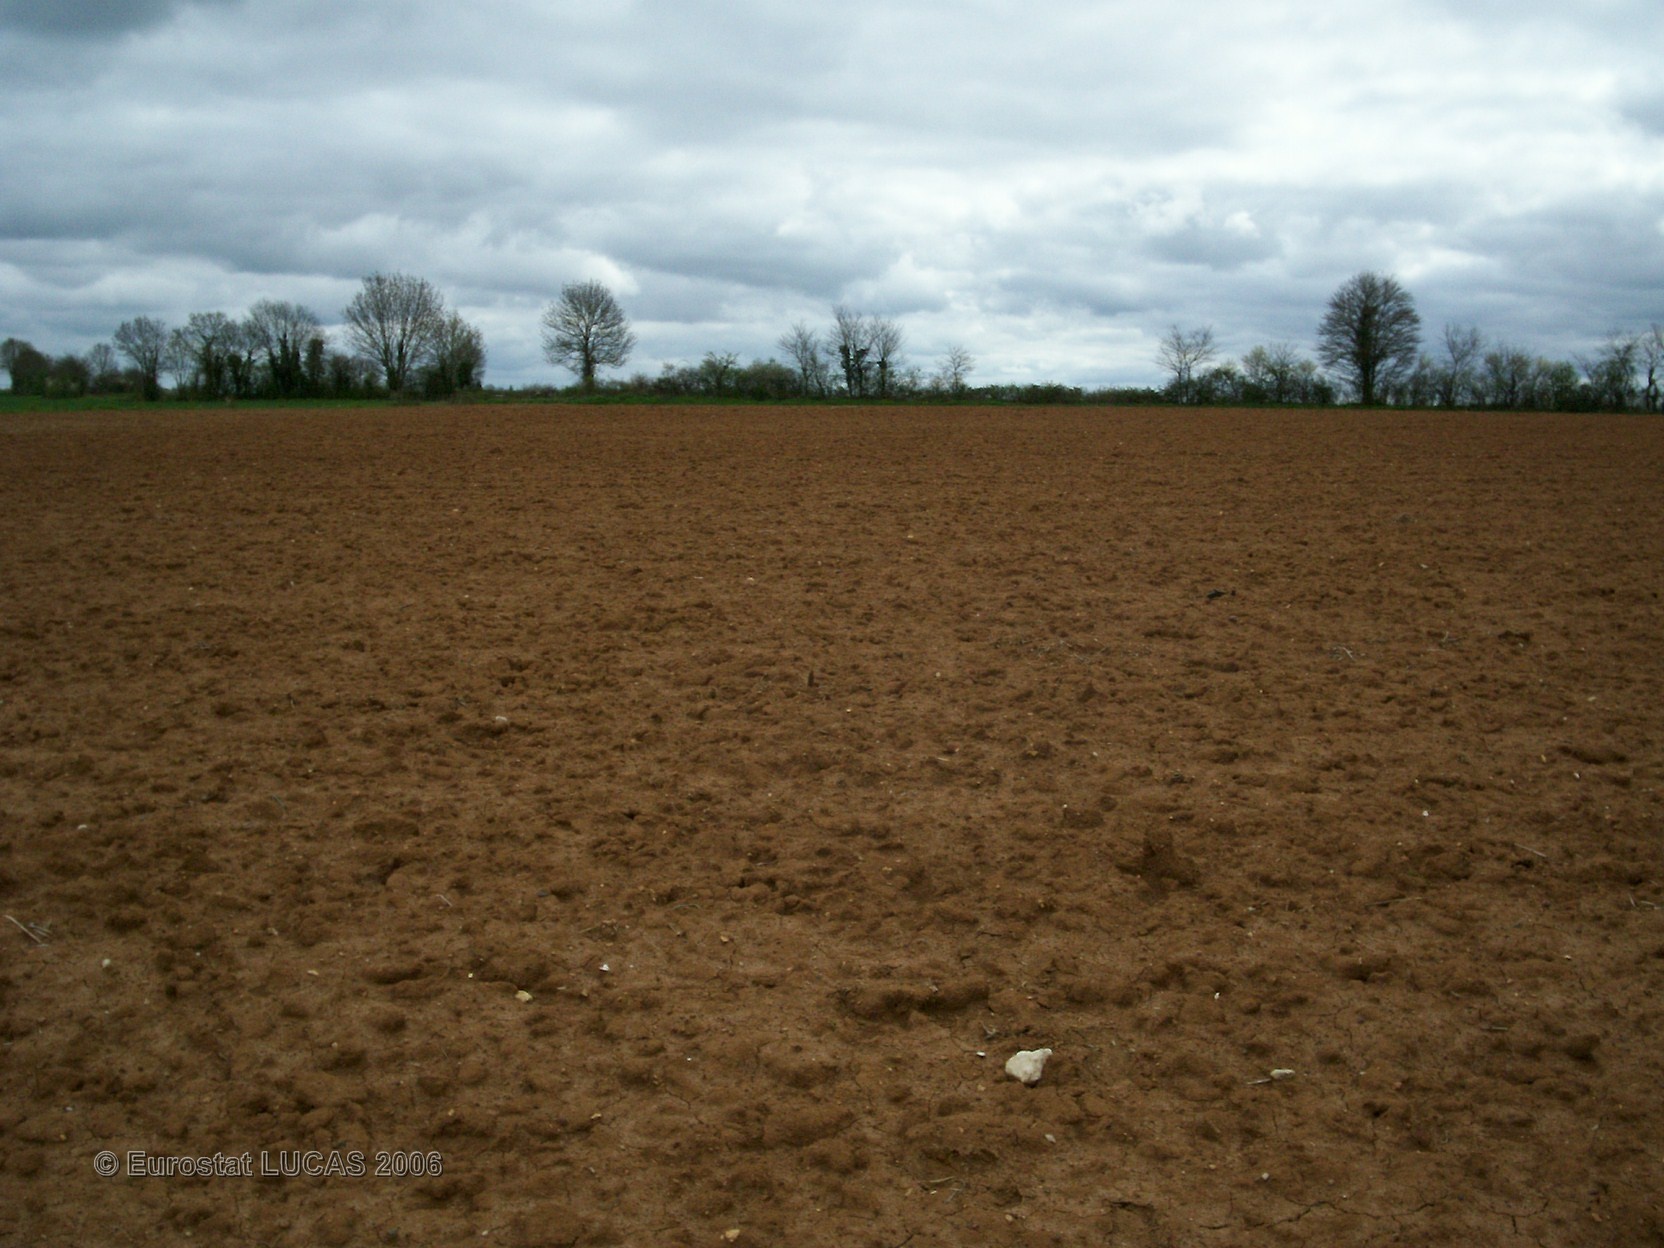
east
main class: Cropland
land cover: Maize
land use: Agriculture (excluding fallow land and kitchen gardens)
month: May
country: FR
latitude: 46.2916
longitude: -0.2651
